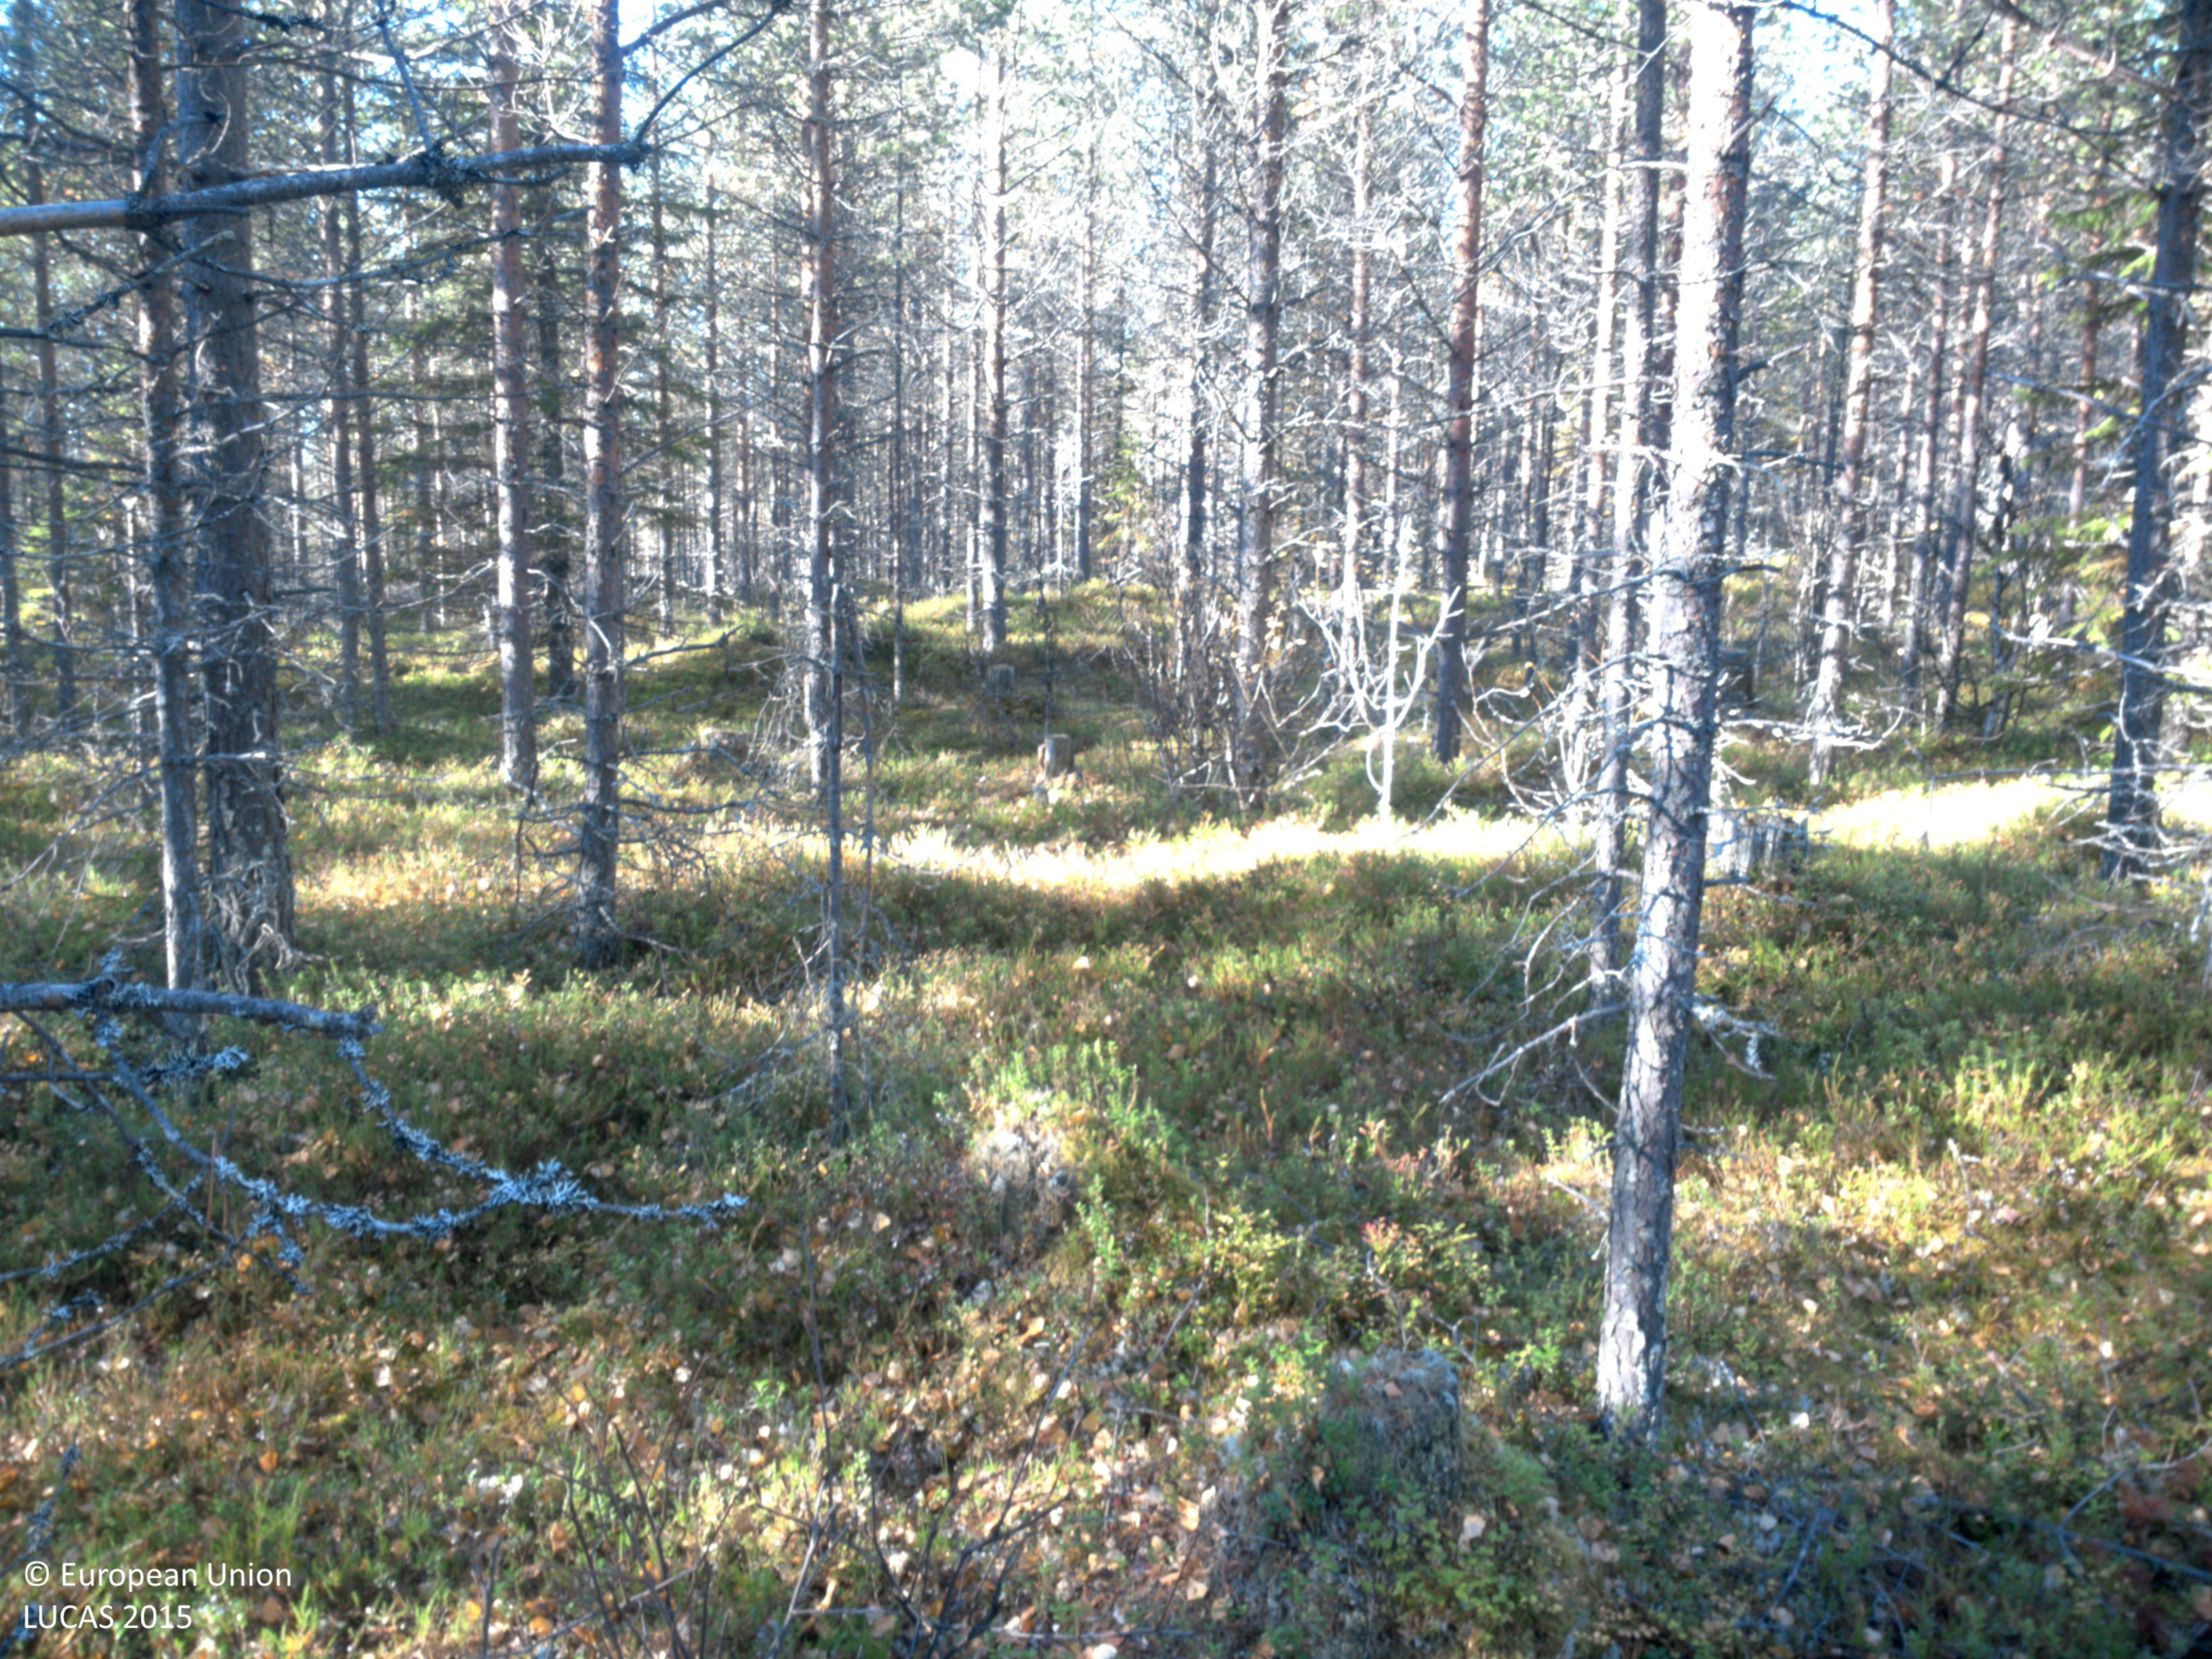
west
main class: Woodland
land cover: Pine dominated coniferous woodland
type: boreal forest
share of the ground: > 75 %
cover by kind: coniferous forest trees 80 %, shrubs 15 %, lichens and mosses 5 %
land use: Forestry
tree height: > 5 m
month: October
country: SE
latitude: 64.8134
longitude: 18.3685
